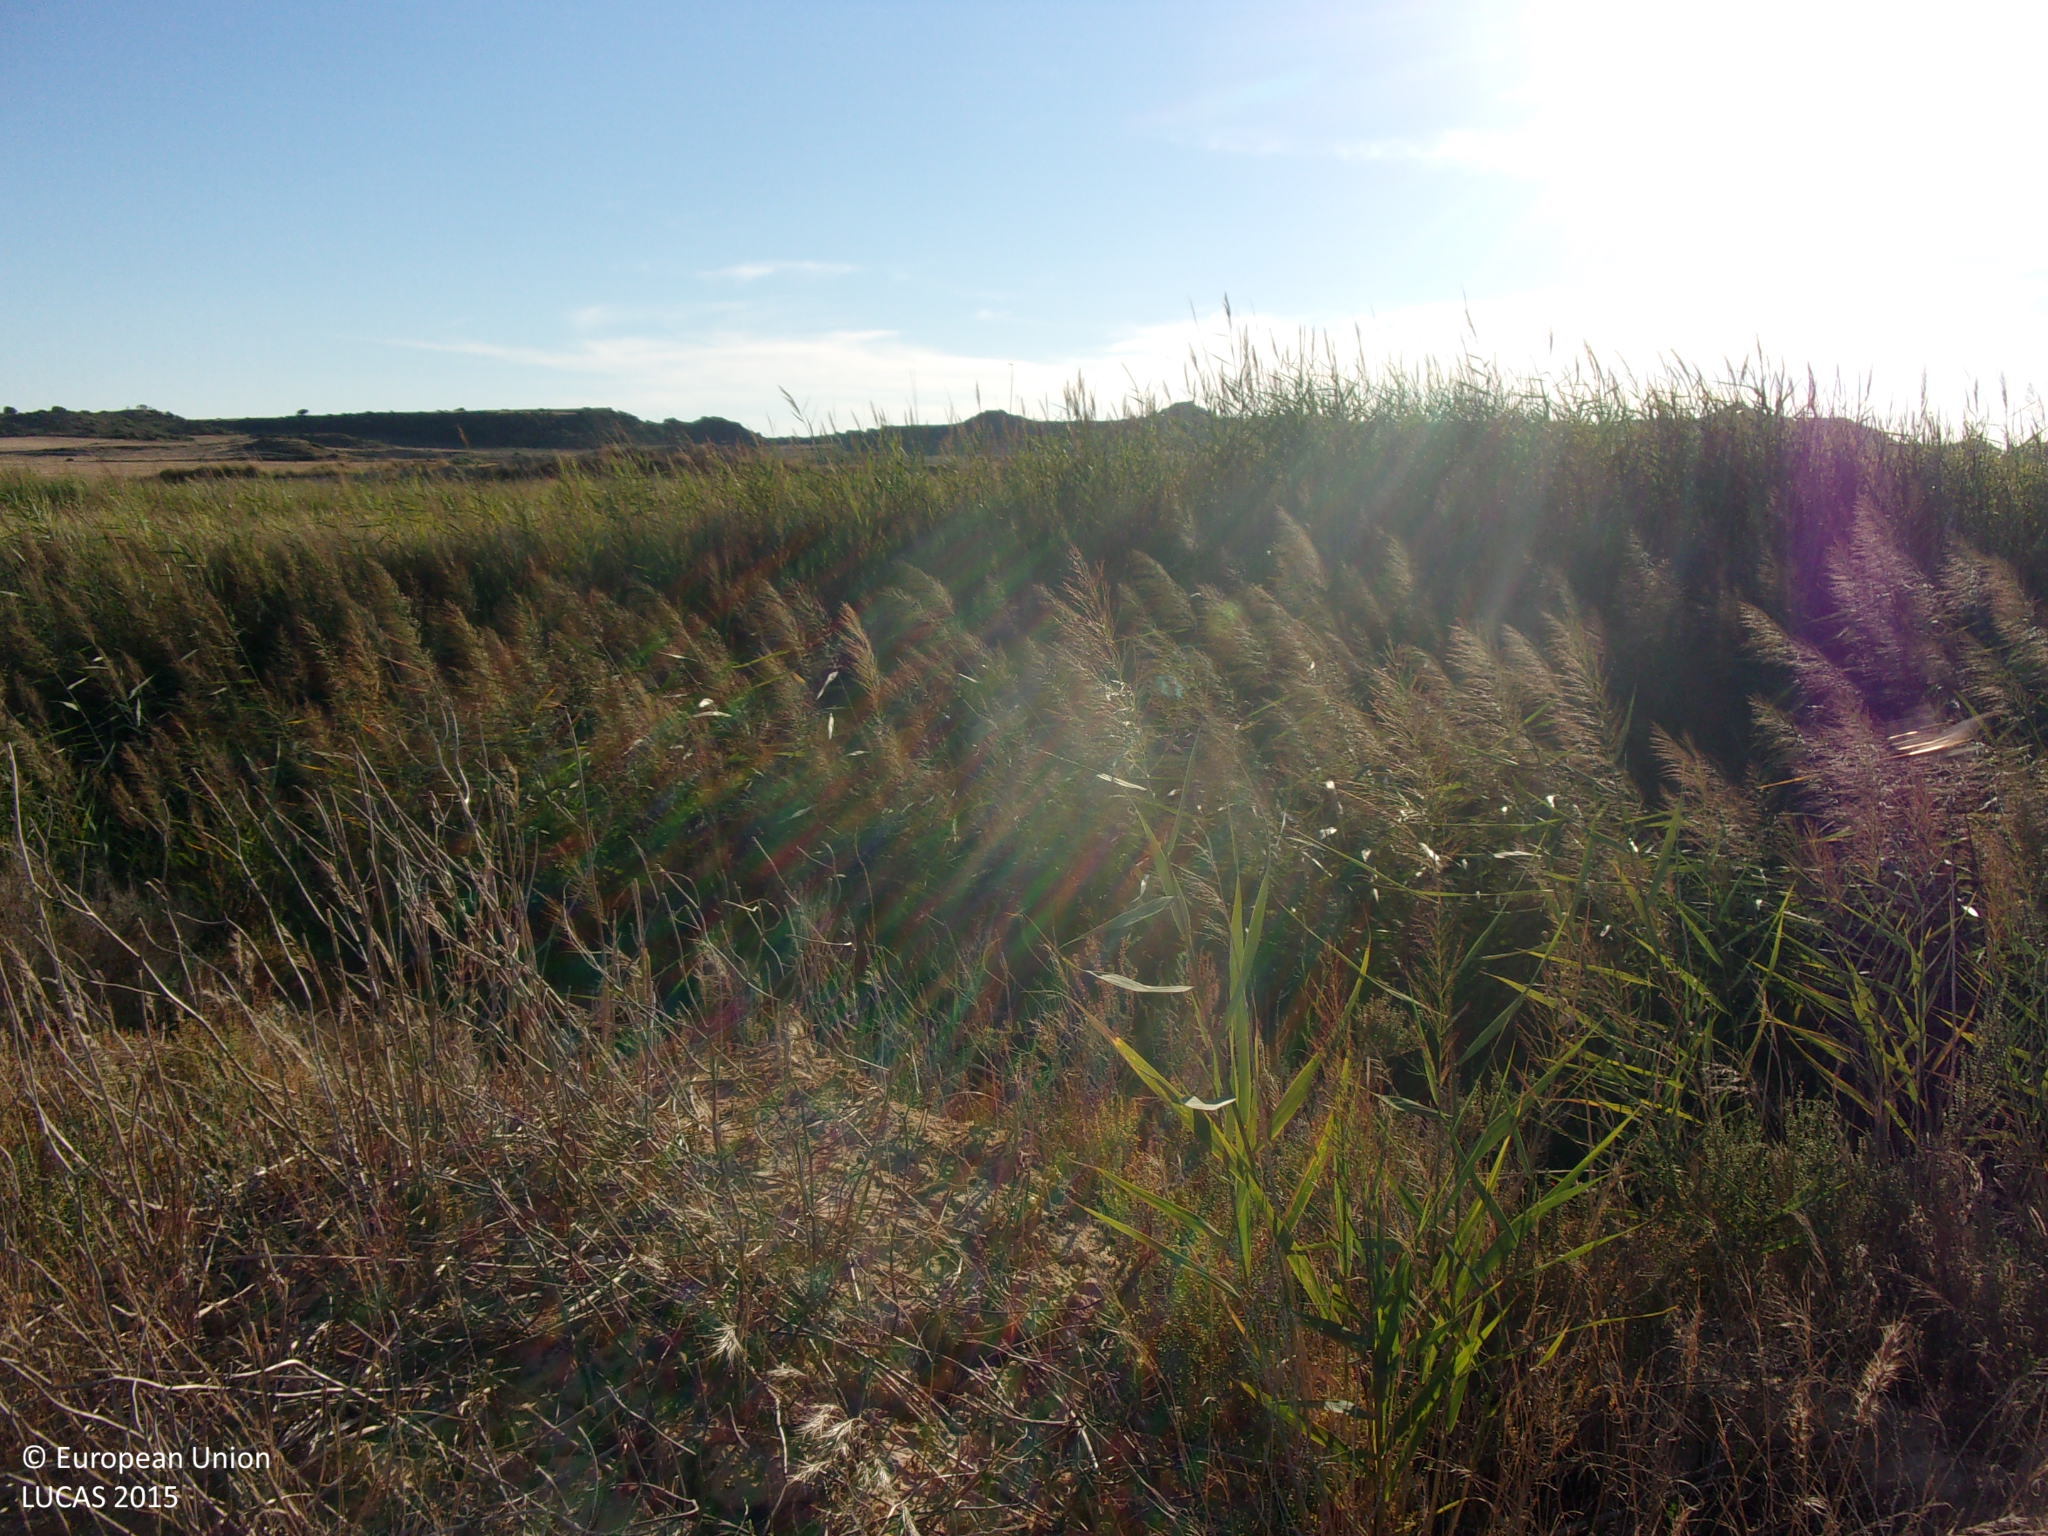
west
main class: Grassland
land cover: Grassland without tree/shrub cover
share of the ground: > 75 %
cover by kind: herbaceous plants 100 %
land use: Abandoned areas
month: August
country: ES
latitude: 42.2670
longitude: -1.3671
